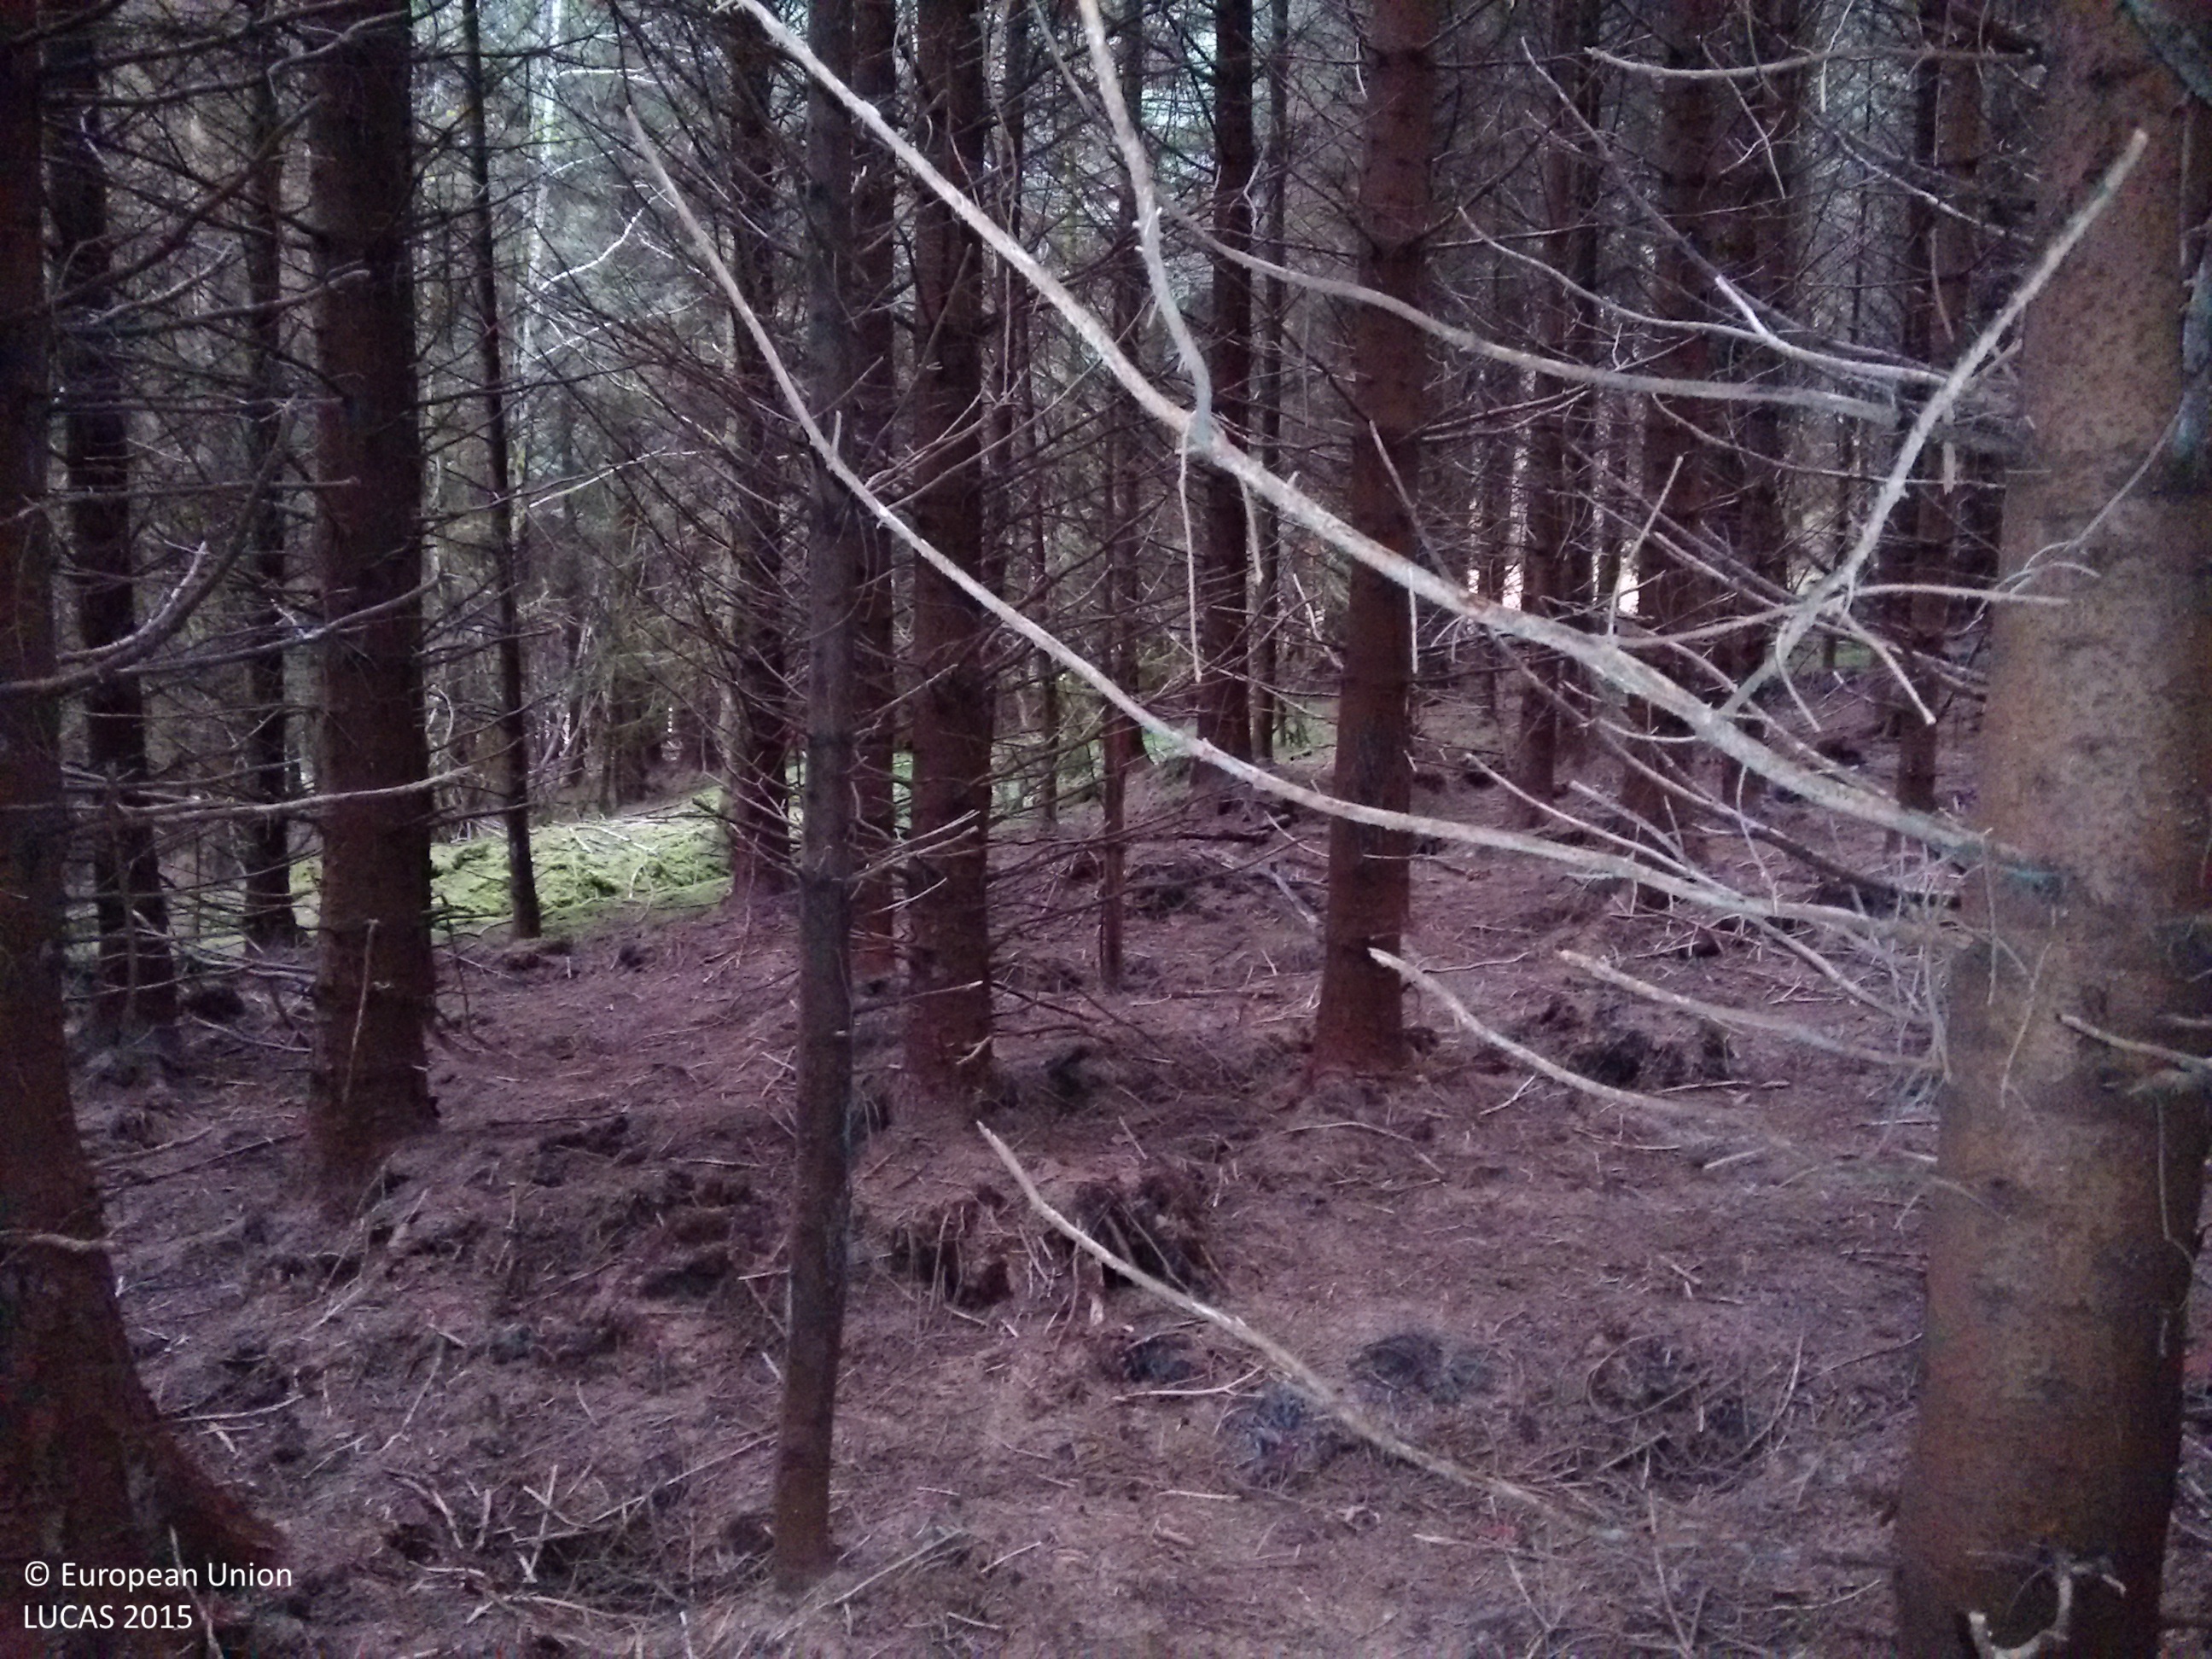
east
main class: Woodland
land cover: Spruce dominated coniferous woodland
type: exotic forest
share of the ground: > 75 %
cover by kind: coniferous forest trees 100 %
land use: Forestry
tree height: > 5 m
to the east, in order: Spruce dominated coniferous woodland; Ditches and canals; Spruce dominated coniferous woodland; Ditches and canals; Spruce dominated coniferous woodland; Tracks; Spruce dominated coniferous woodland
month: October
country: GB
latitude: 54.5217
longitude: -7.9217
